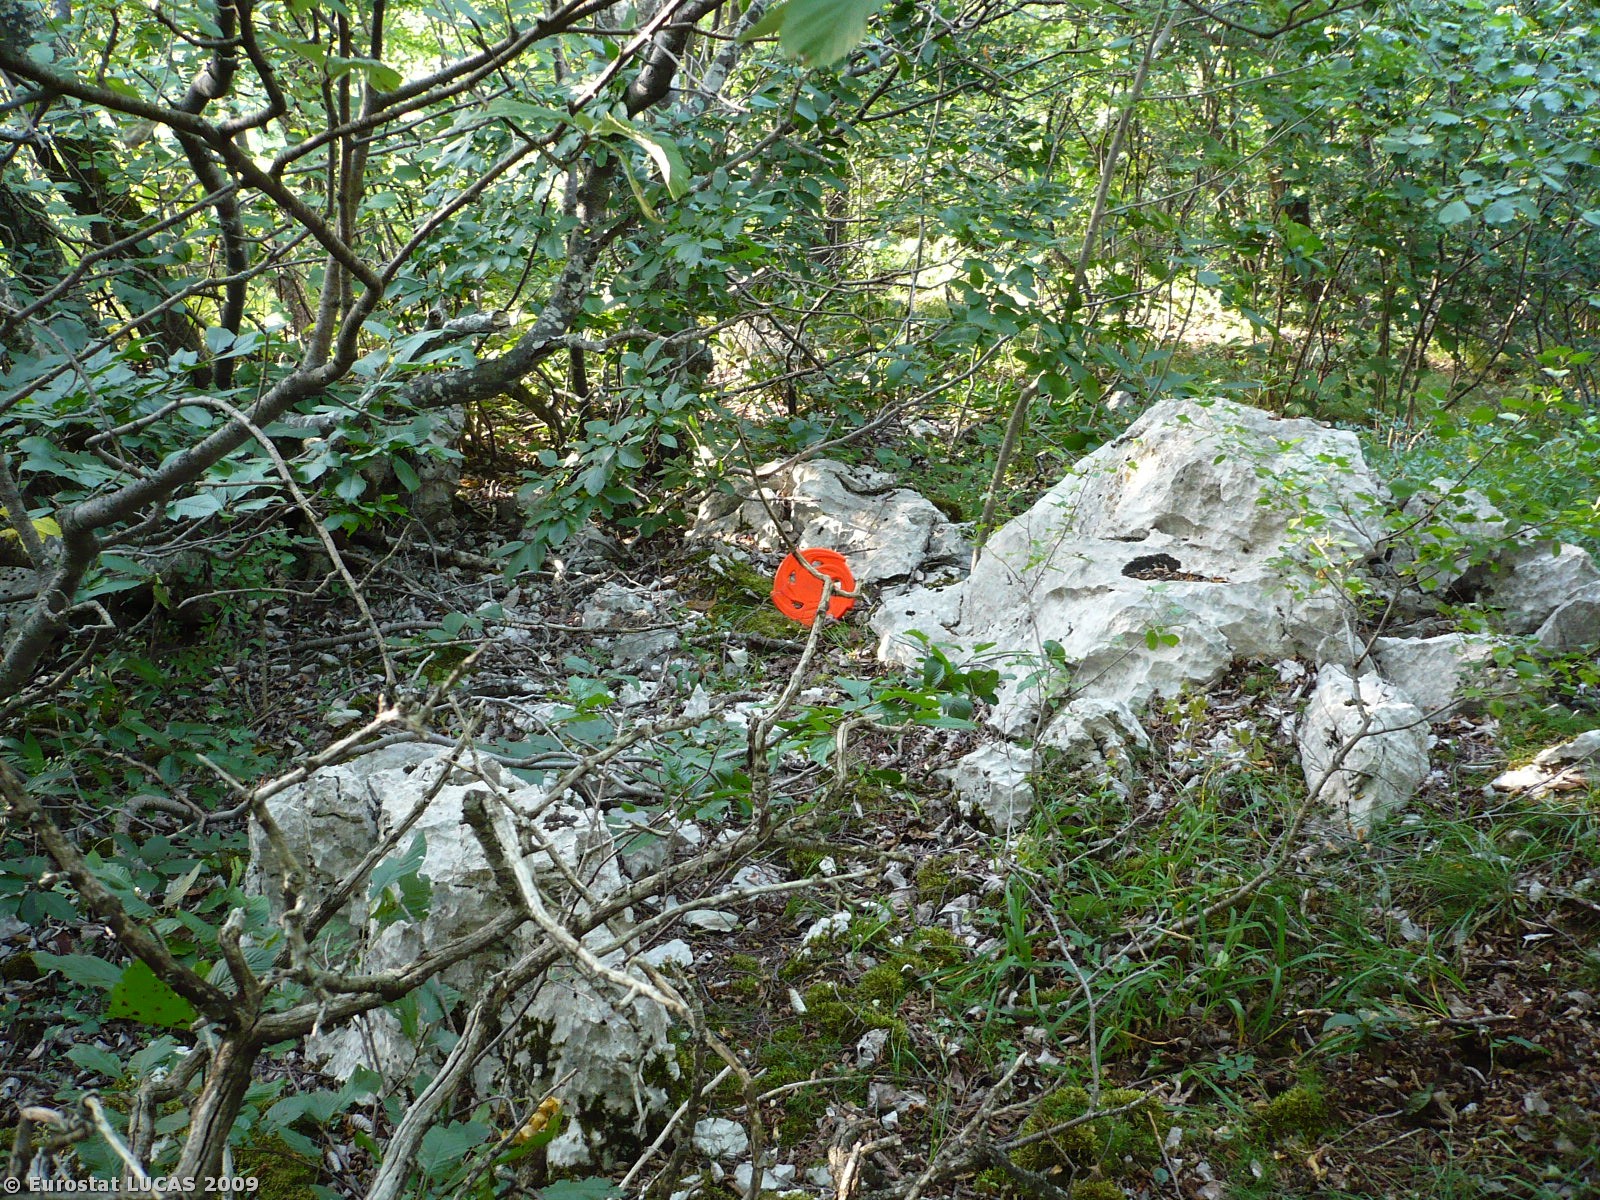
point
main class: Woodland
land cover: Broadleaved woodland
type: thermophilous deciduous forest
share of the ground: > 75 %
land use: Unused
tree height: > 5 m
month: July
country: SI
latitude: 45.5607
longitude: 14.3129
